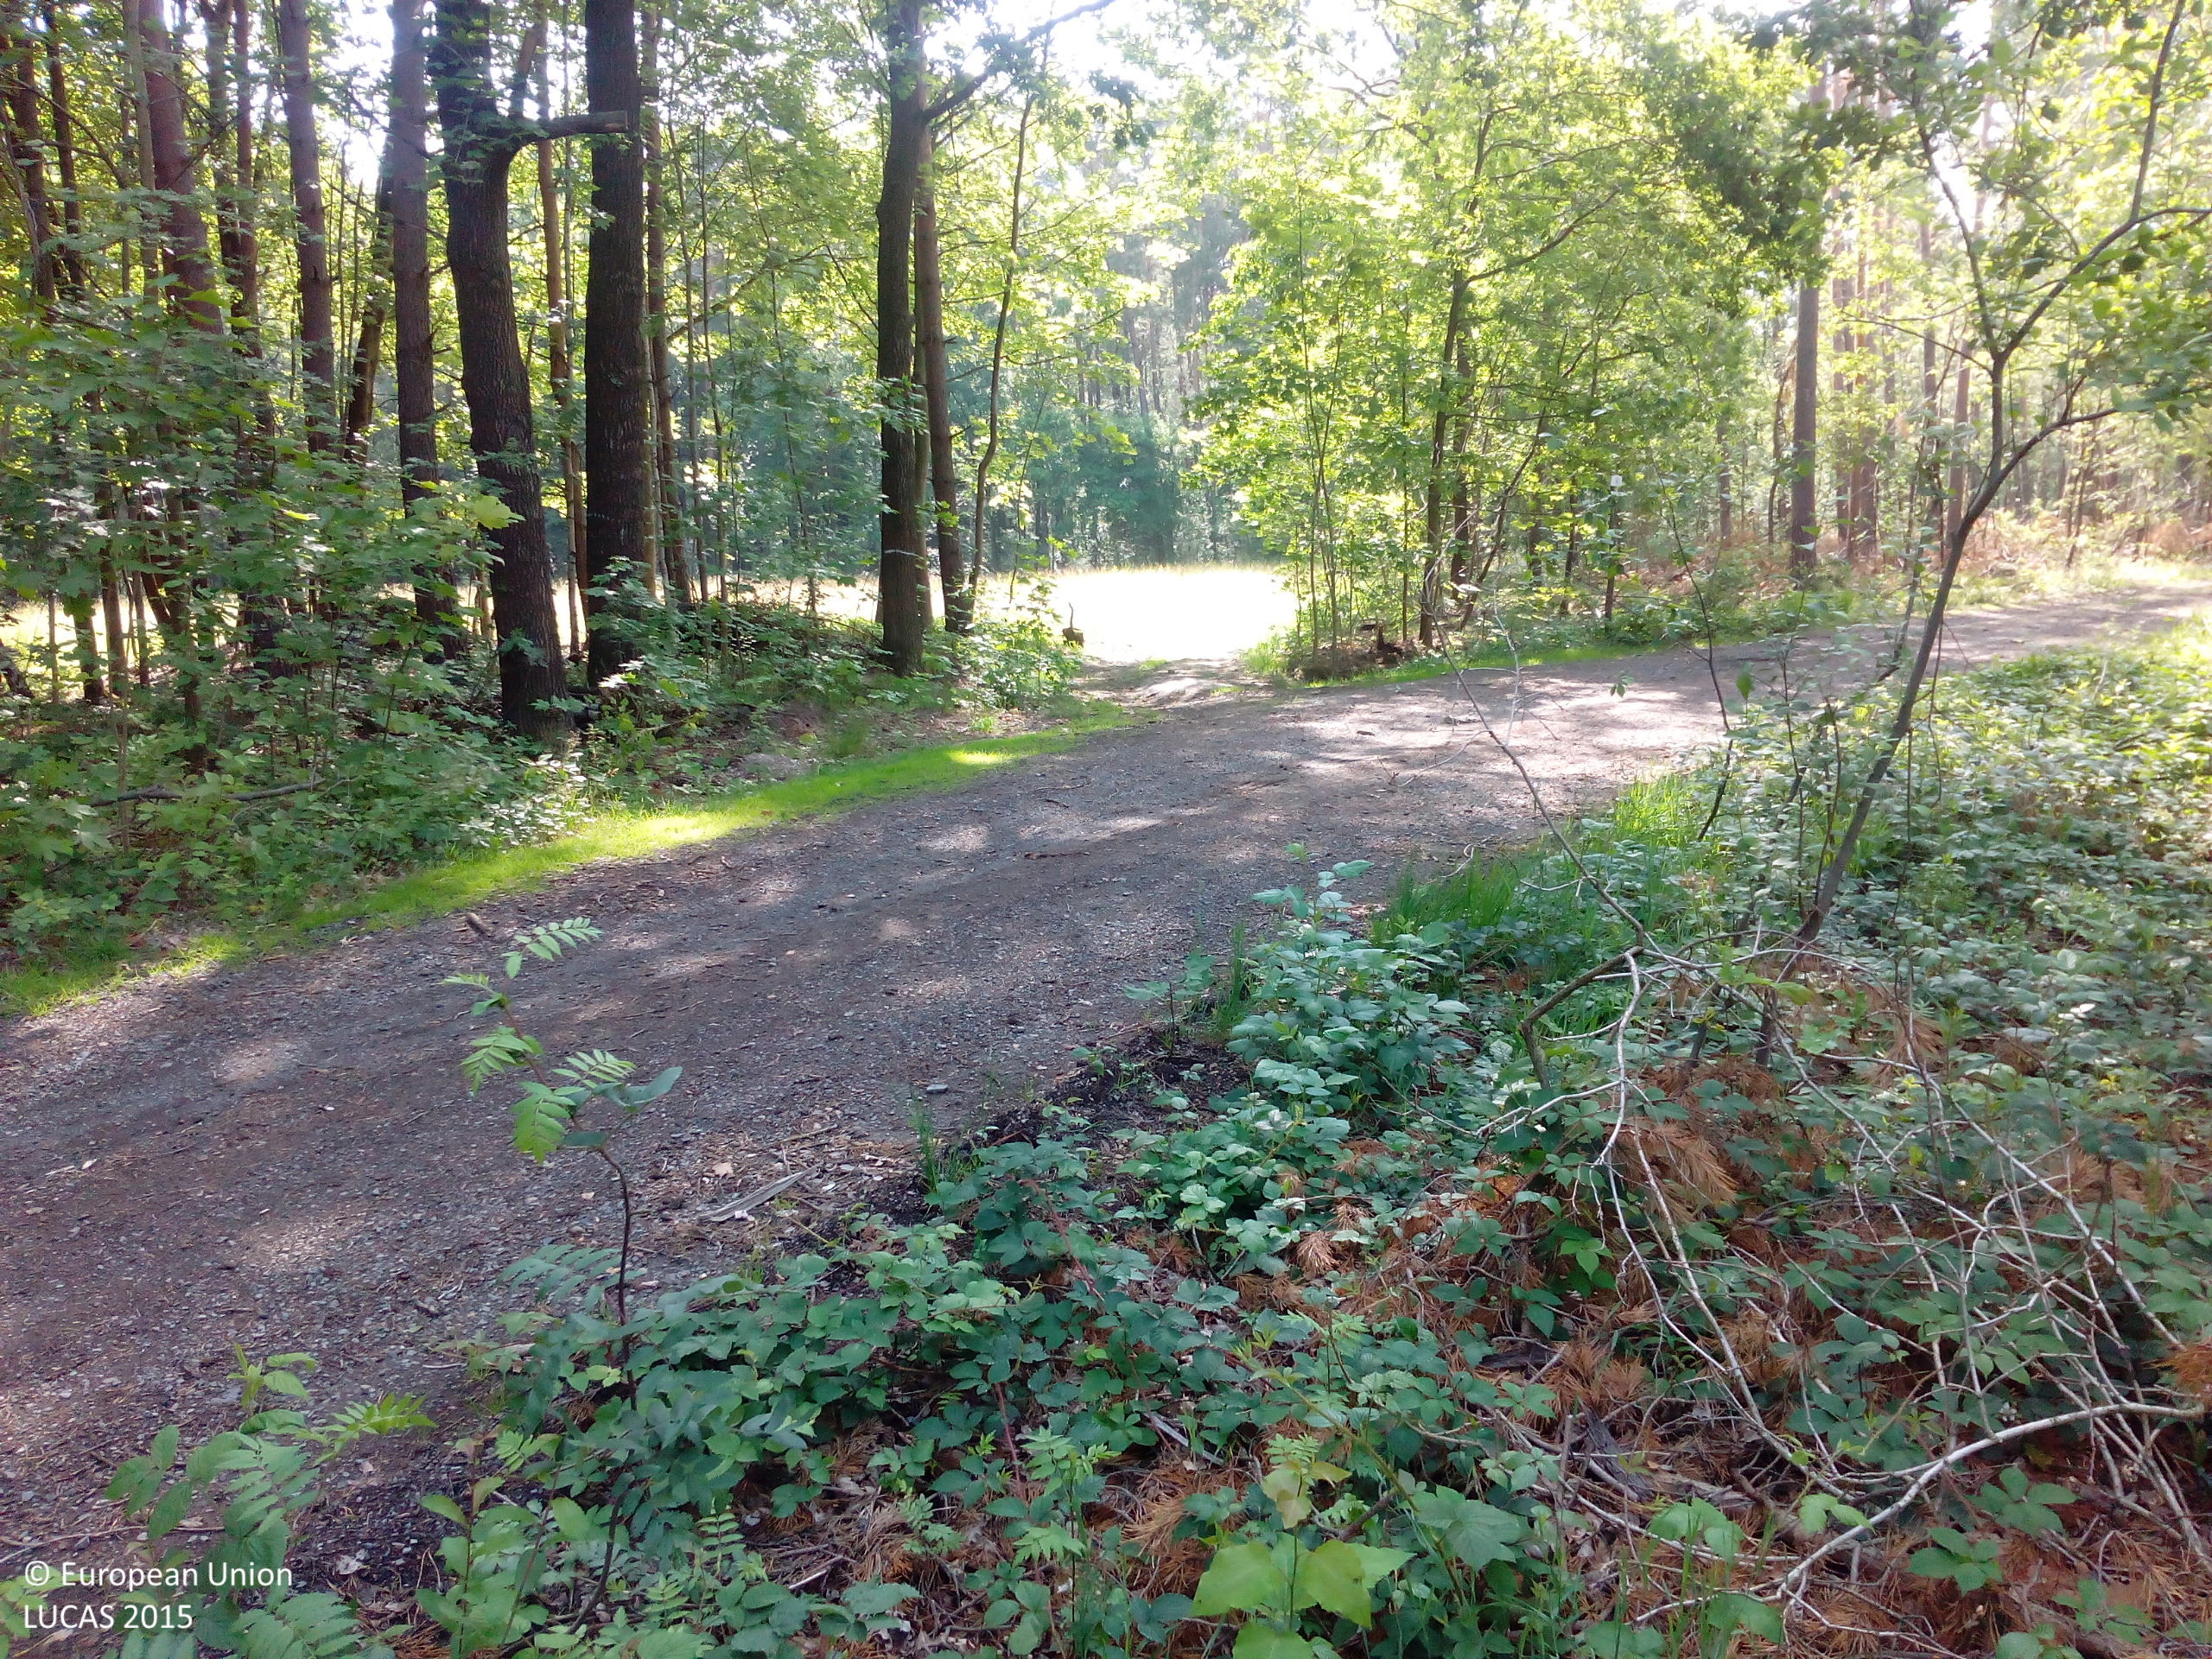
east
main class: Woodland
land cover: Pine dominated mixed woodland
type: hemiboreal forest and nemoral coniferous forest and mixed broadleaved-coniferous forest
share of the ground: 25 - 50 %
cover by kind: shrubs 35 %, coniferous forest trees 25 %, broadleaved forest trees 20 %, unconsolidated bare surface 20 %
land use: Forestry
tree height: > 5 m
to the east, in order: Pine dominated mixed woodland; Tracks; Pine dominated mixed woodland; Ditches and canals; Pine dominated mixed woodland; Grassland without tree/shrub cover; Pine dominated mixed woodland; Ditches and canals; Tracks; Pine dominated mixed woodland; Broadleaved woodland
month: June
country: DE
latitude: 51.2842
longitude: 14.0013
